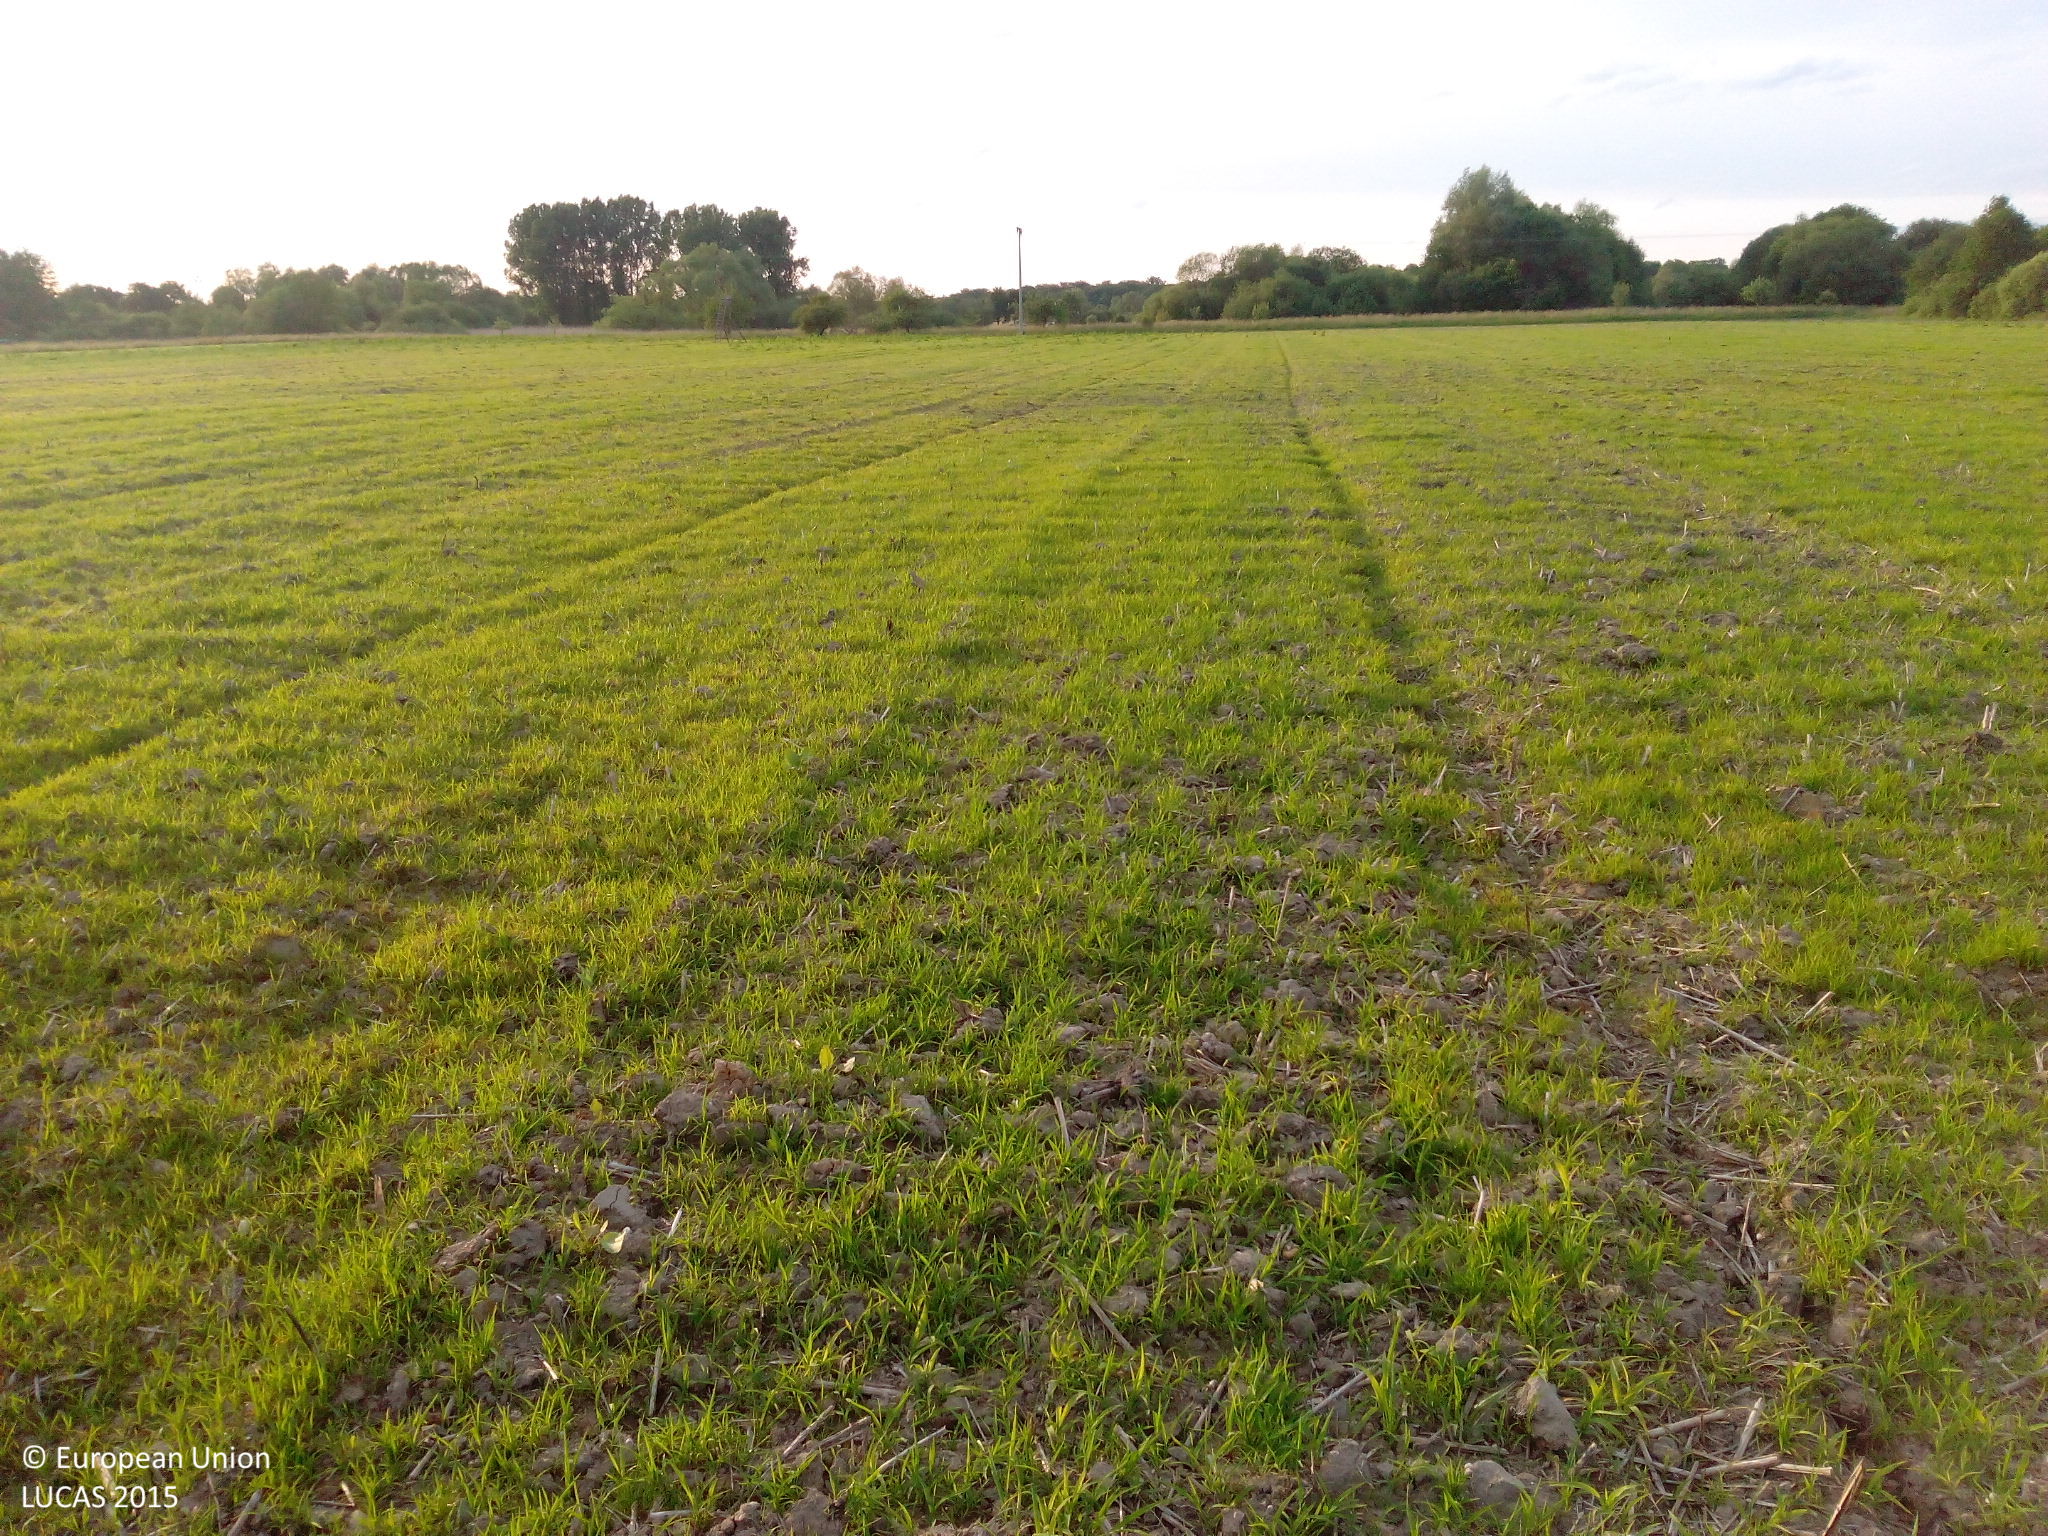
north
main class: Cropland
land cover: Temporary grasslands
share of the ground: 25 - 50 %
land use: Agriculture (excluding fallow land and kitchen gardens)
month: May
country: DE
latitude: 49.0184
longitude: 8.1820
